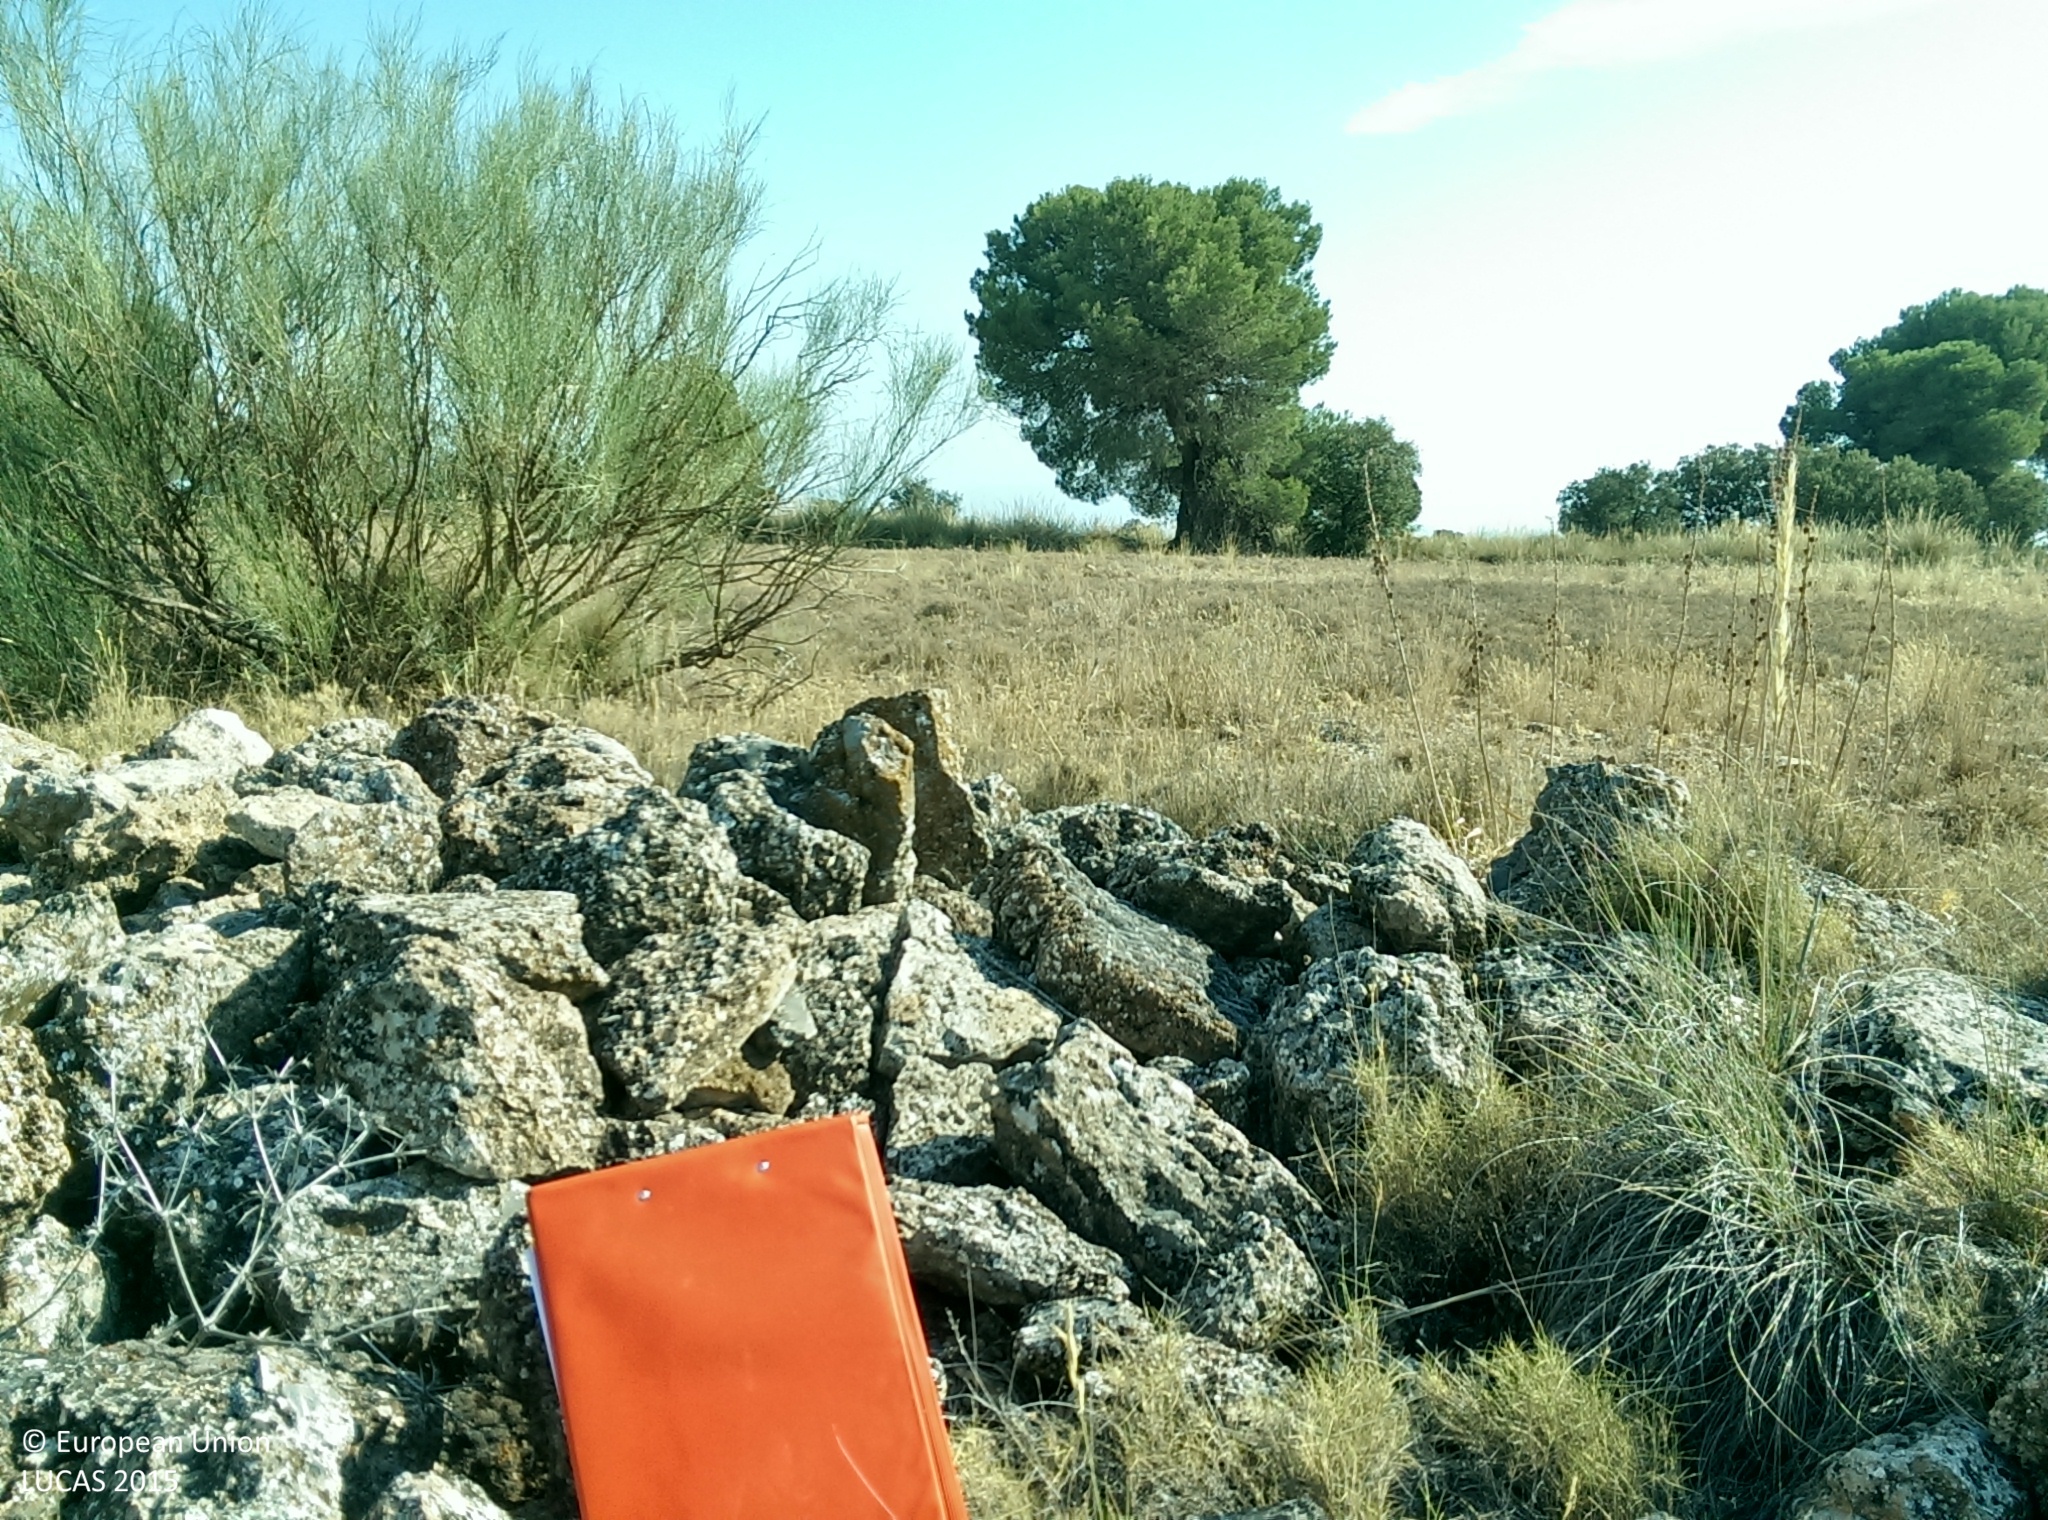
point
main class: Grassland
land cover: Grassland with sparse tree/shrub cover
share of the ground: > 75 %
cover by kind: herbaceous plants 80 %, consolidated bare surface 10 %, broadleaved forest trees 5 %, shrubs 5 %
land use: Semi-natural and natural areas not in use
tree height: < 5 m
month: July
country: ES
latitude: 37.4625
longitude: -2.9559
